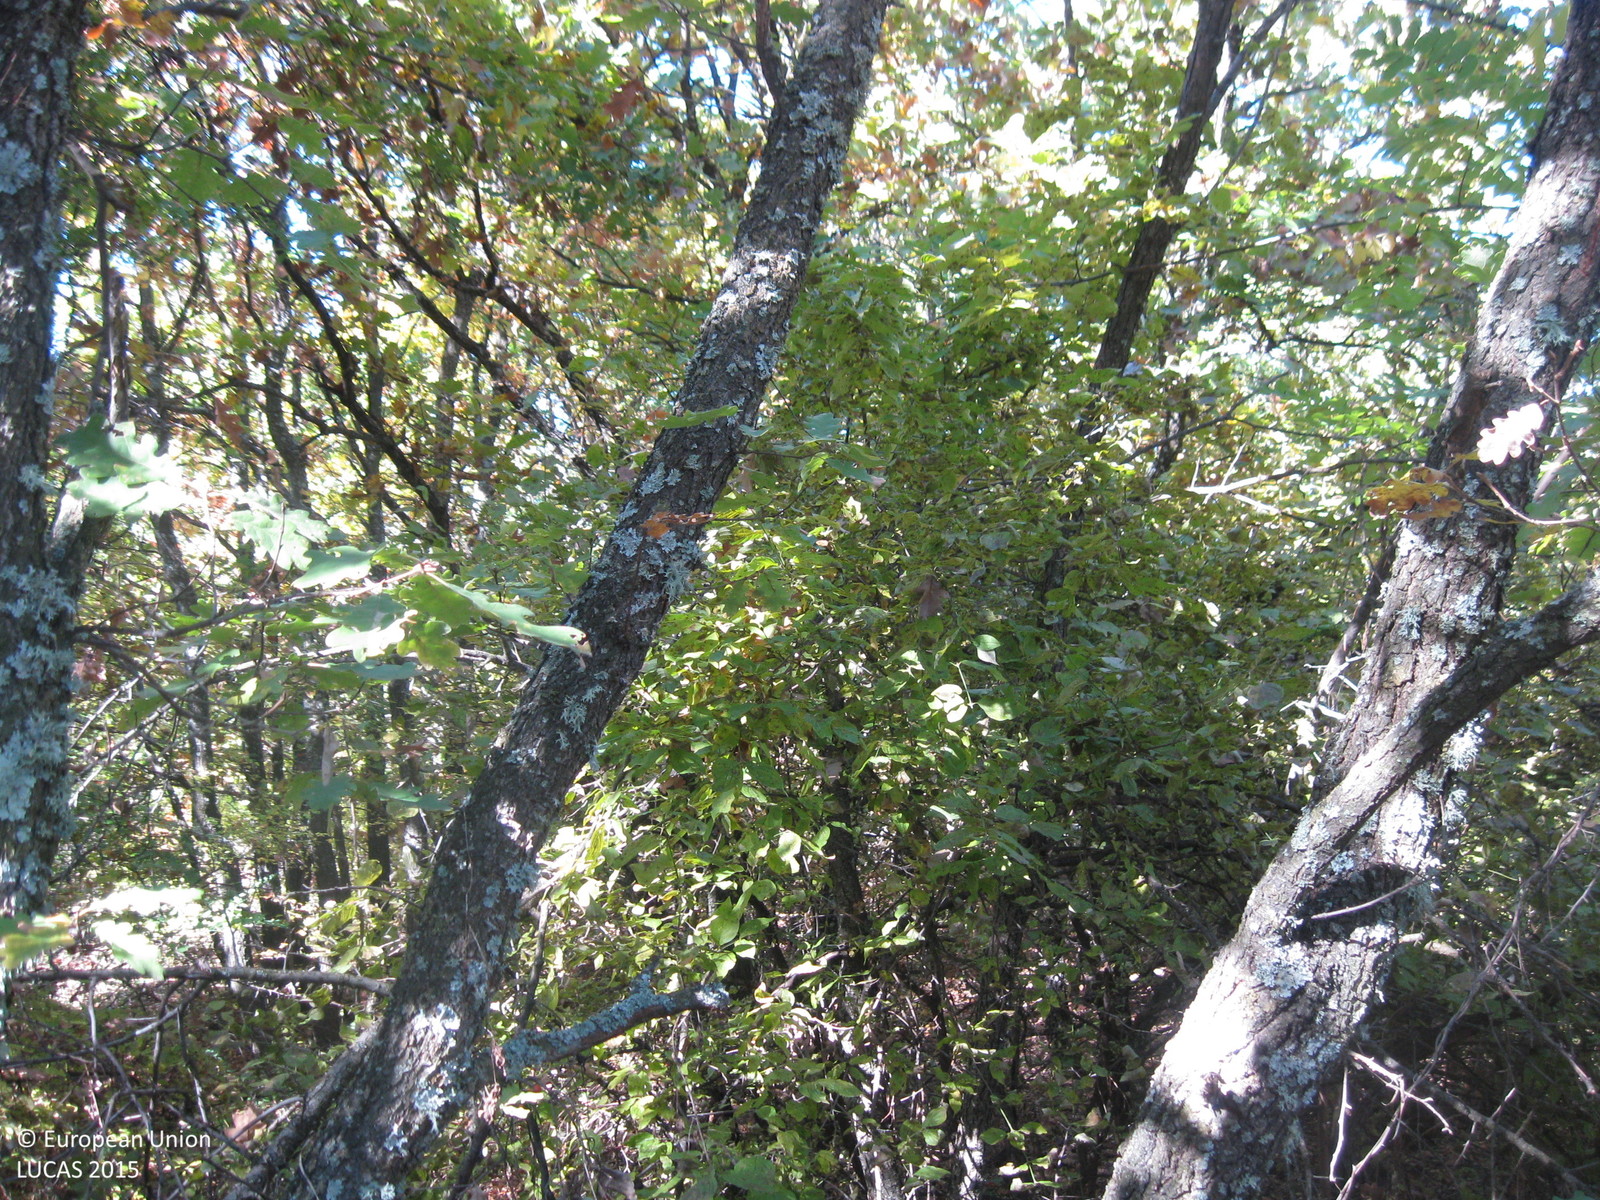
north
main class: Woodland
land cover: Broadleaved woodland
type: thermophilous deciduous forest
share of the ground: > 75 %
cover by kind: broadleaved forest trees 90 %, shrubs 5 %, herbaceous plants 5 %
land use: Forestry
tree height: > 5 m
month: November
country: BG
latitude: 42.3531
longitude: 24.2614
